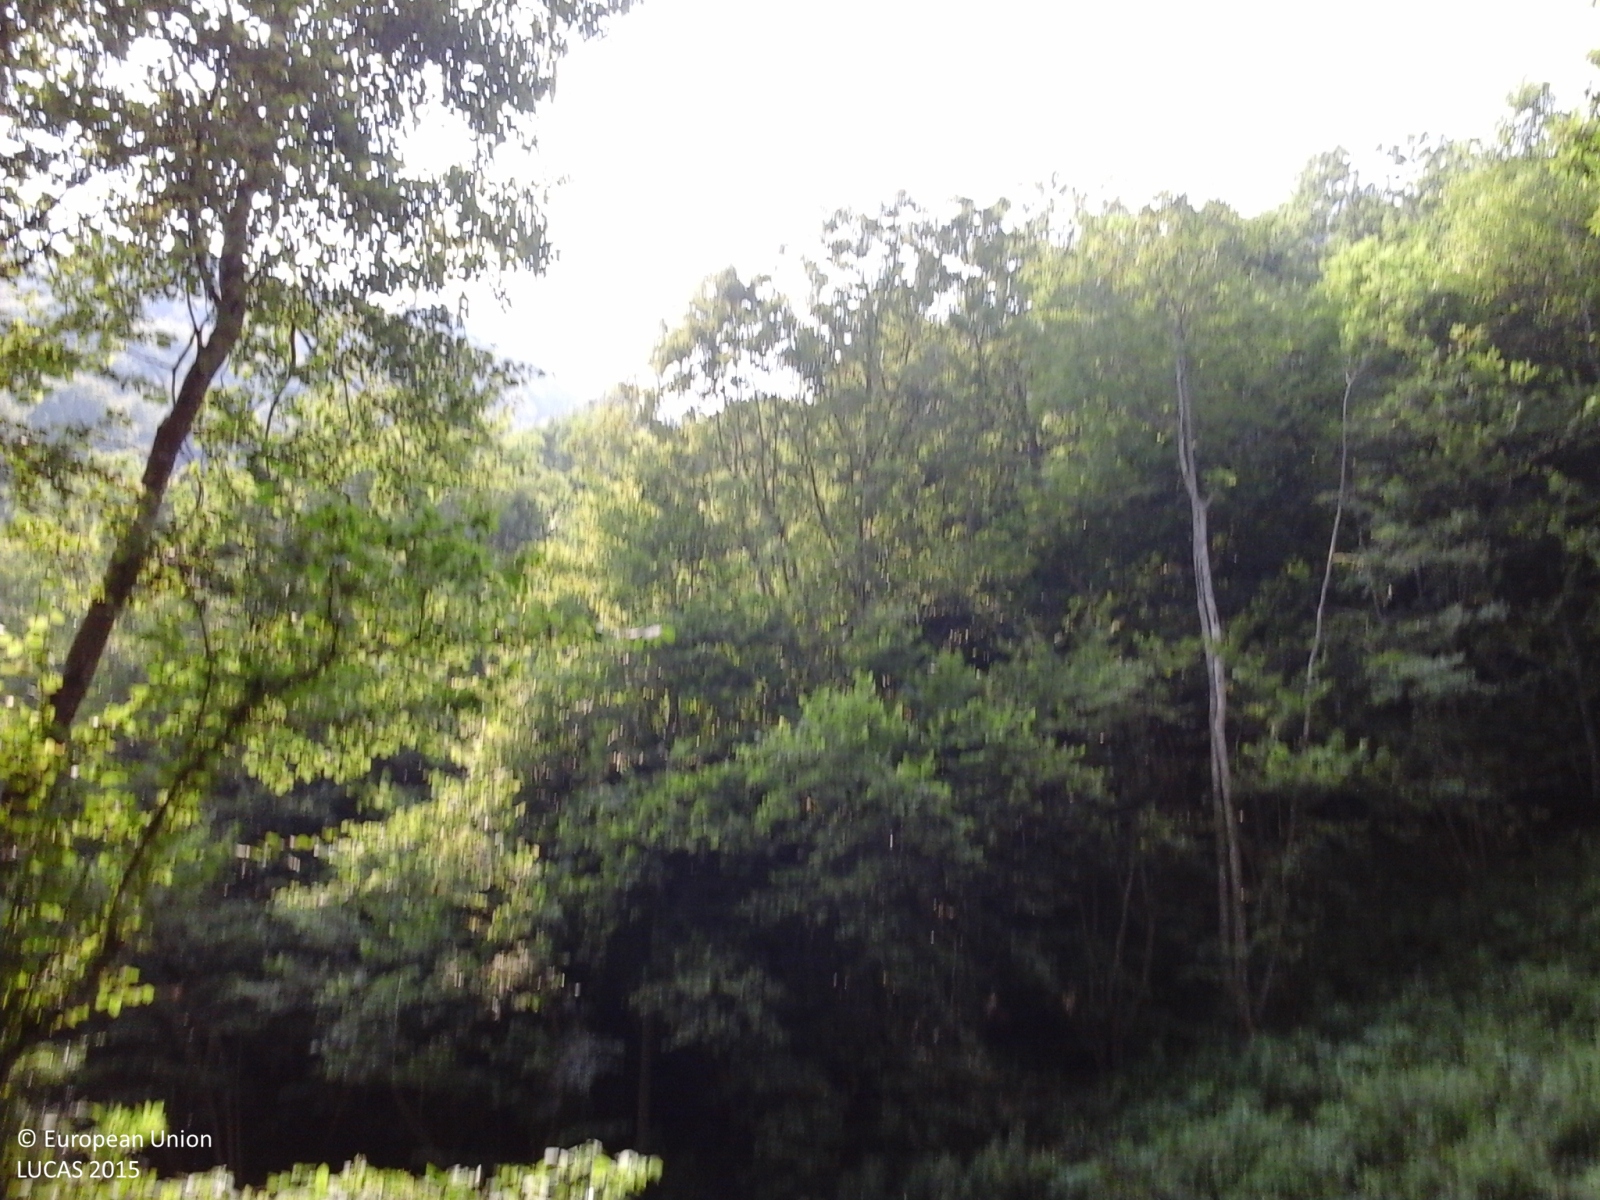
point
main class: Woodland
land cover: Broadleaved woodland
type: mountainous beech forest
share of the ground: > 75 %
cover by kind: broadleaved forest trees 100 %
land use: Forestry
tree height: > 5 m
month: July
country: IT
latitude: 44.4045
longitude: 7.2557
